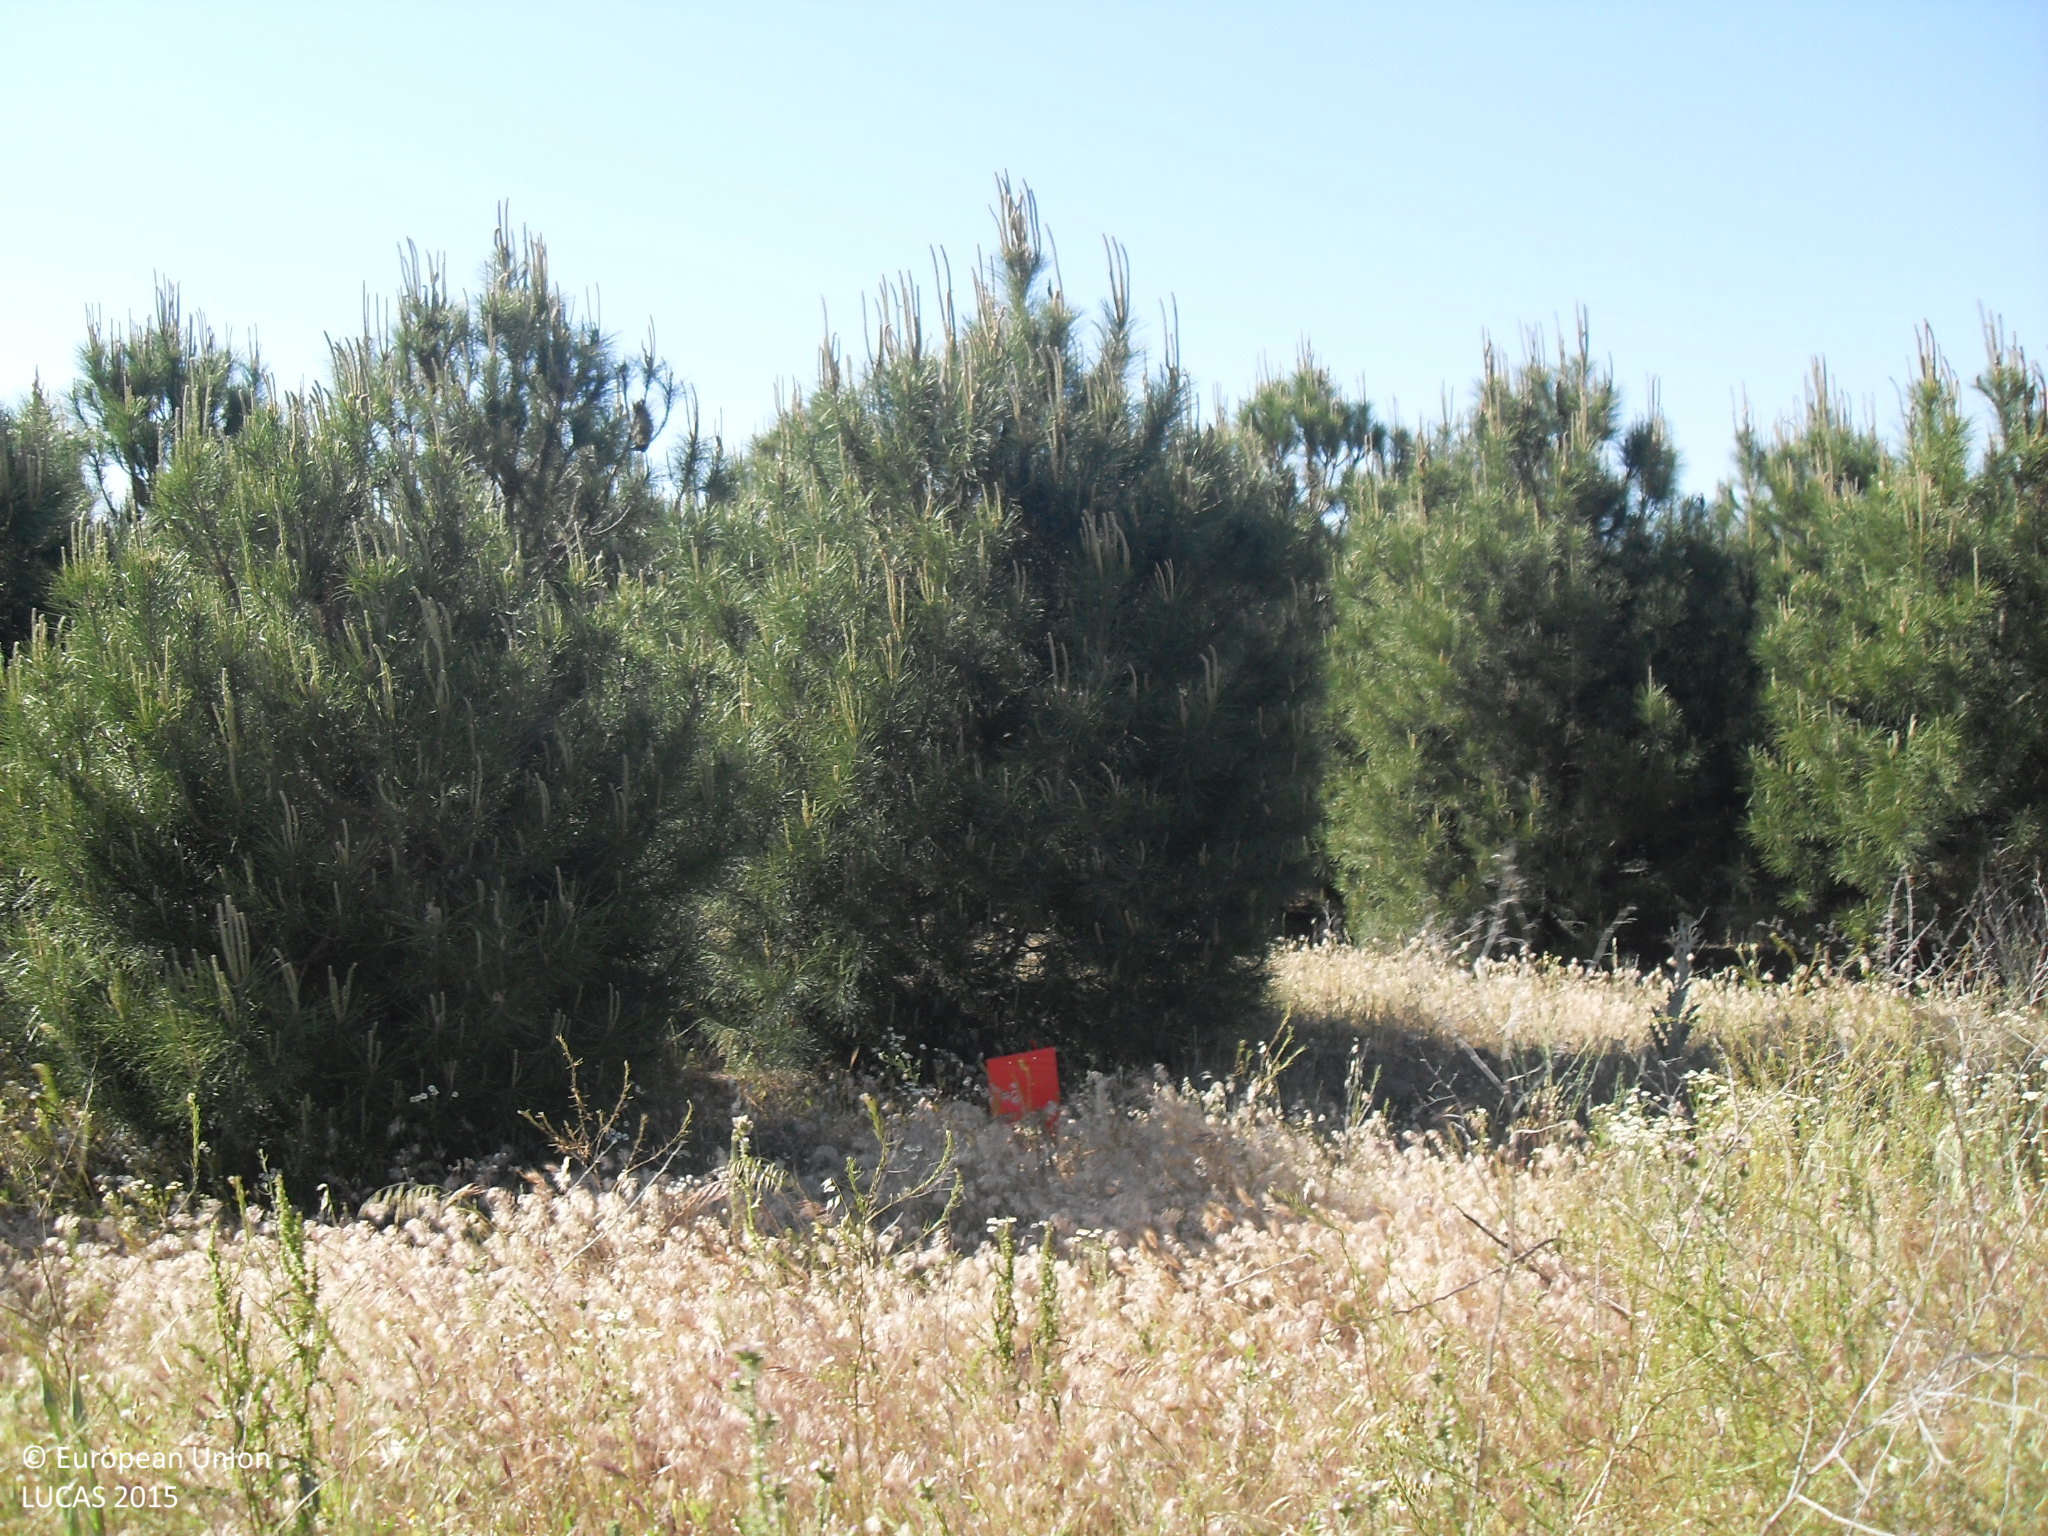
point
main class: Woodland
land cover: Pine dominated coniferous woodland
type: coniferous forest of the mediterranean region
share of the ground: 50 - 75 %
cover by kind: coniferous forest trees 60 %, herbaceous plants 40 %
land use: Forestry
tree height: < 5 m
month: May
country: ES
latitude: 41.0135
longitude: -5.2548
